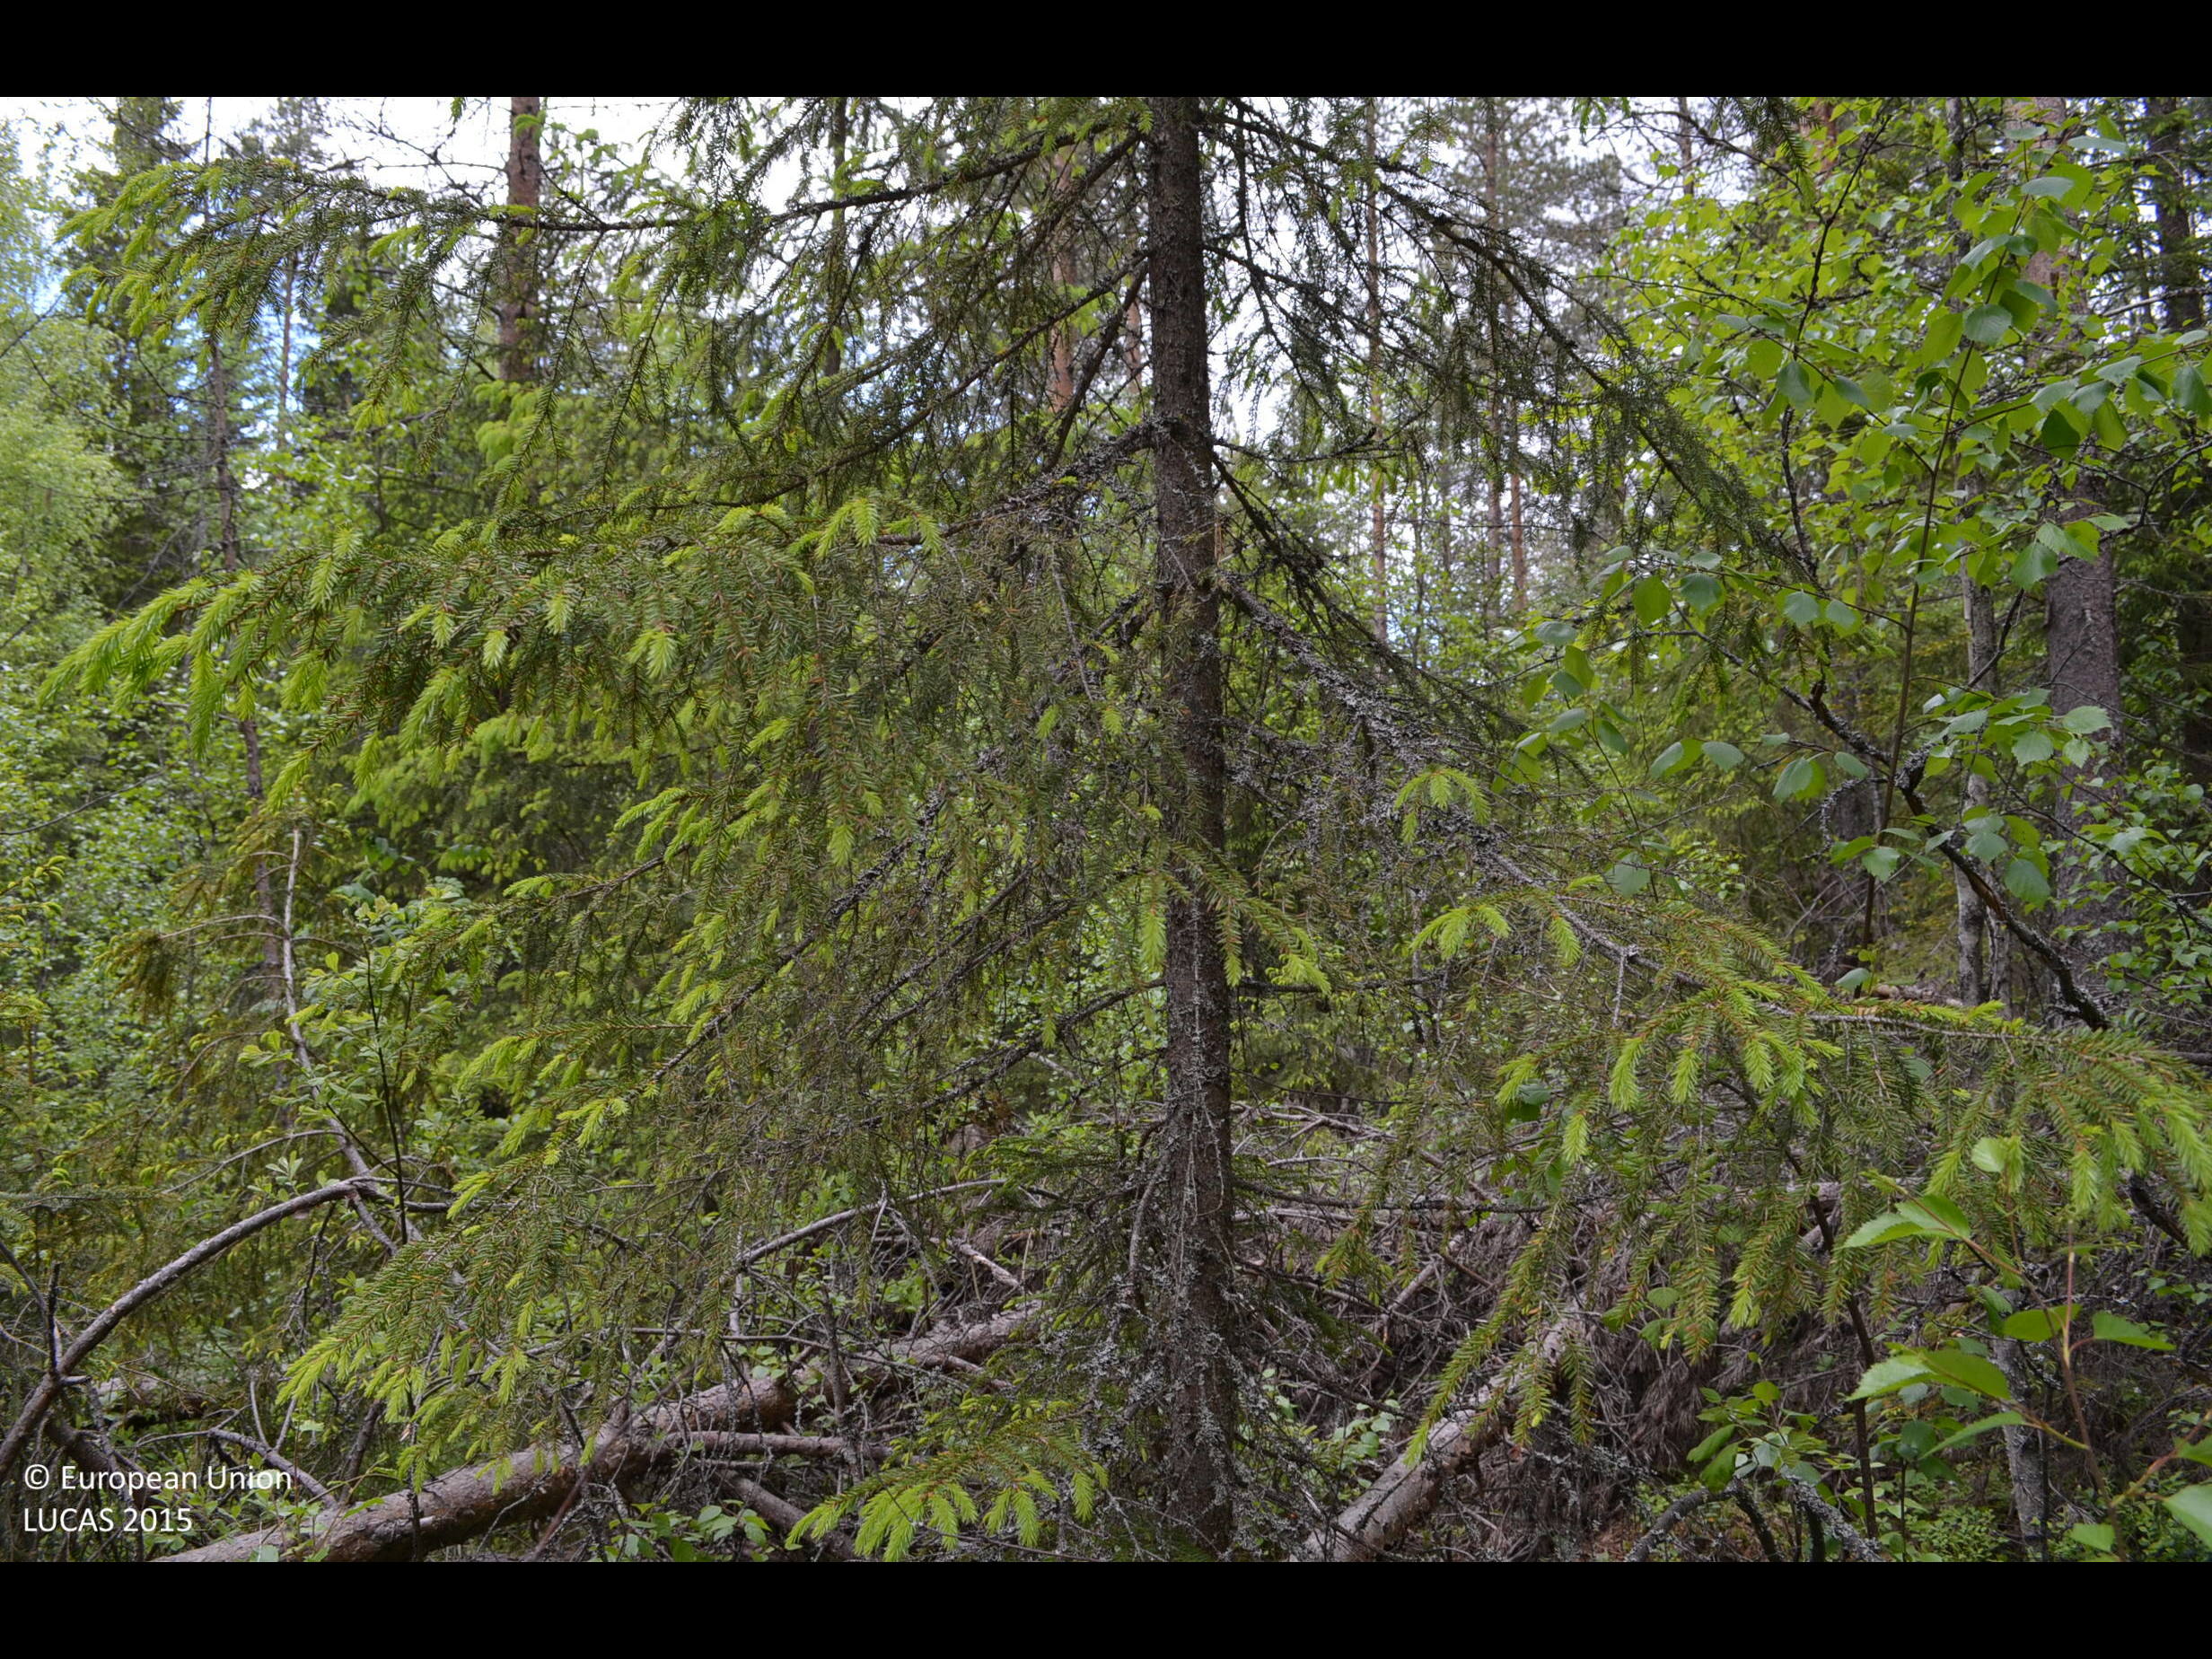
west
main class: Woodland
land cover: Pine dominated mixed woodland
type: boreal forest
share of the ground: > 75 %
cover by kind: coniferous forest trees 65 %, broadleaved forest trees 25 %, shrubs 10 %
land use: Forestry
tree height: > 5 m
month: June
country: FI
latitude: 61.9690
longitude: 23.4459
